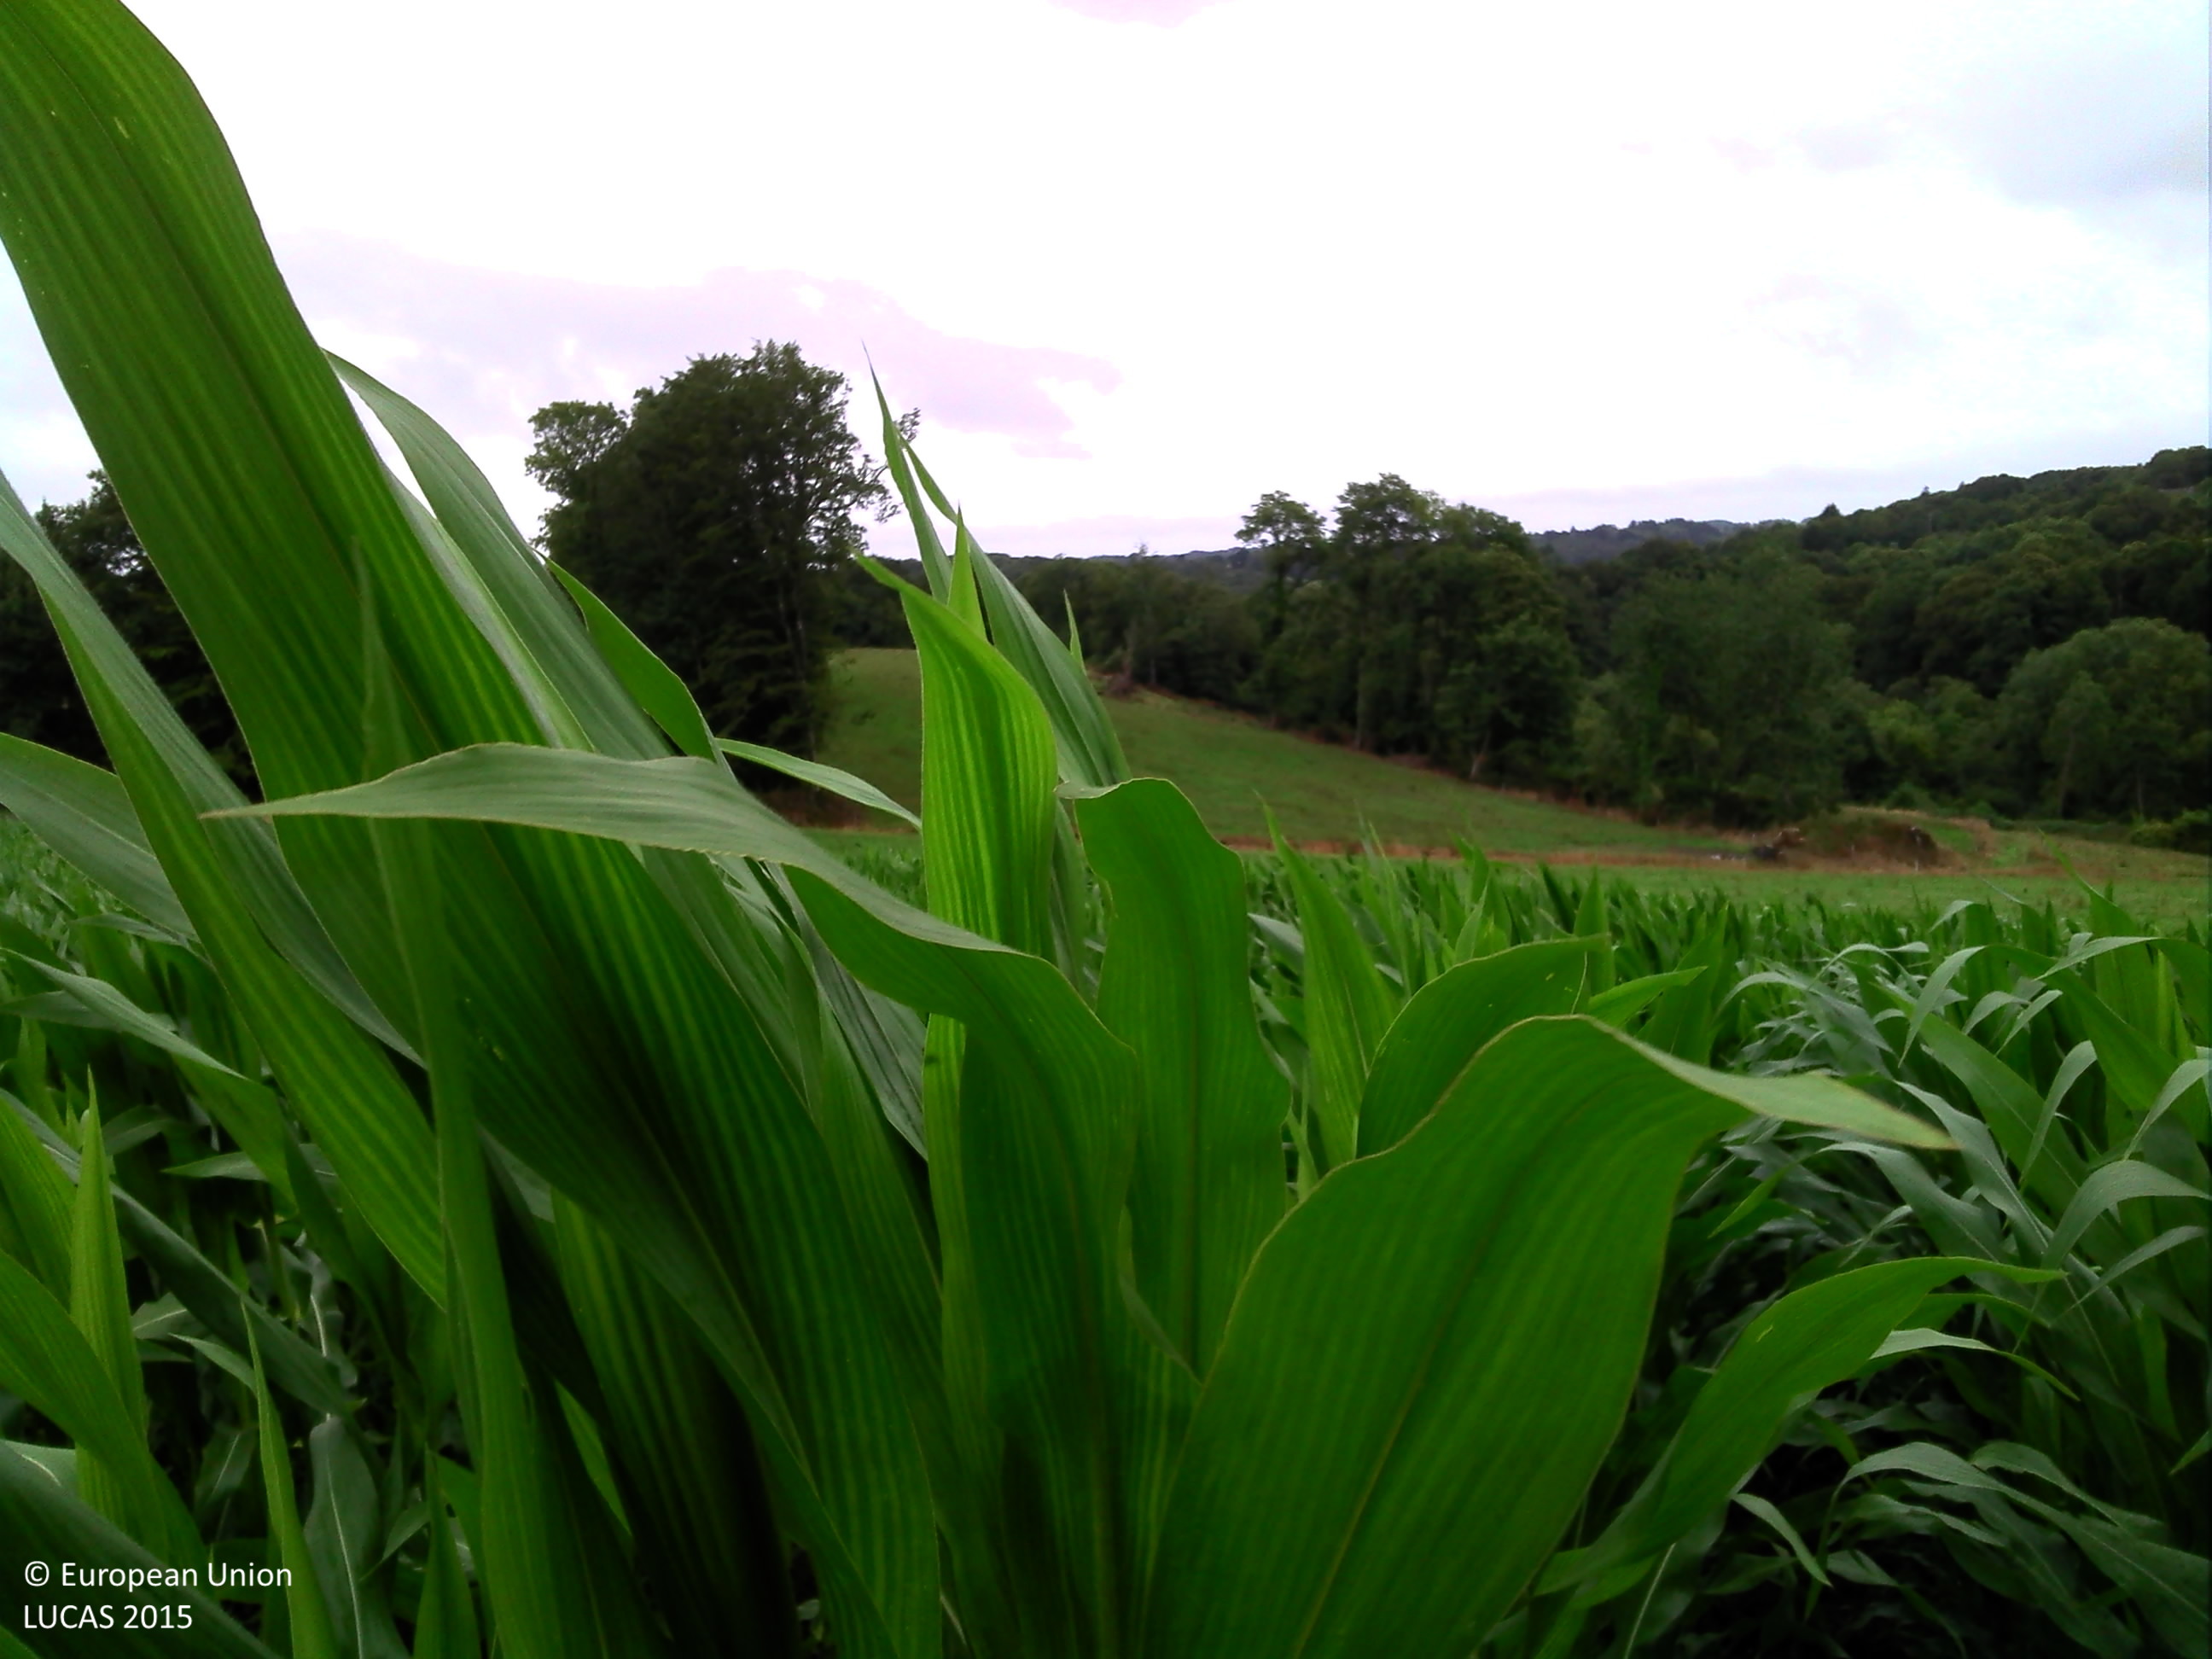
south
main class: Cropland
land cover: Maize
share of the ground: > 75 %
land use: Agriculture (excluding fallow land and kitchen gardens)
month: July
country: FR
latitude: 48.0027
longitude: -3.5478
